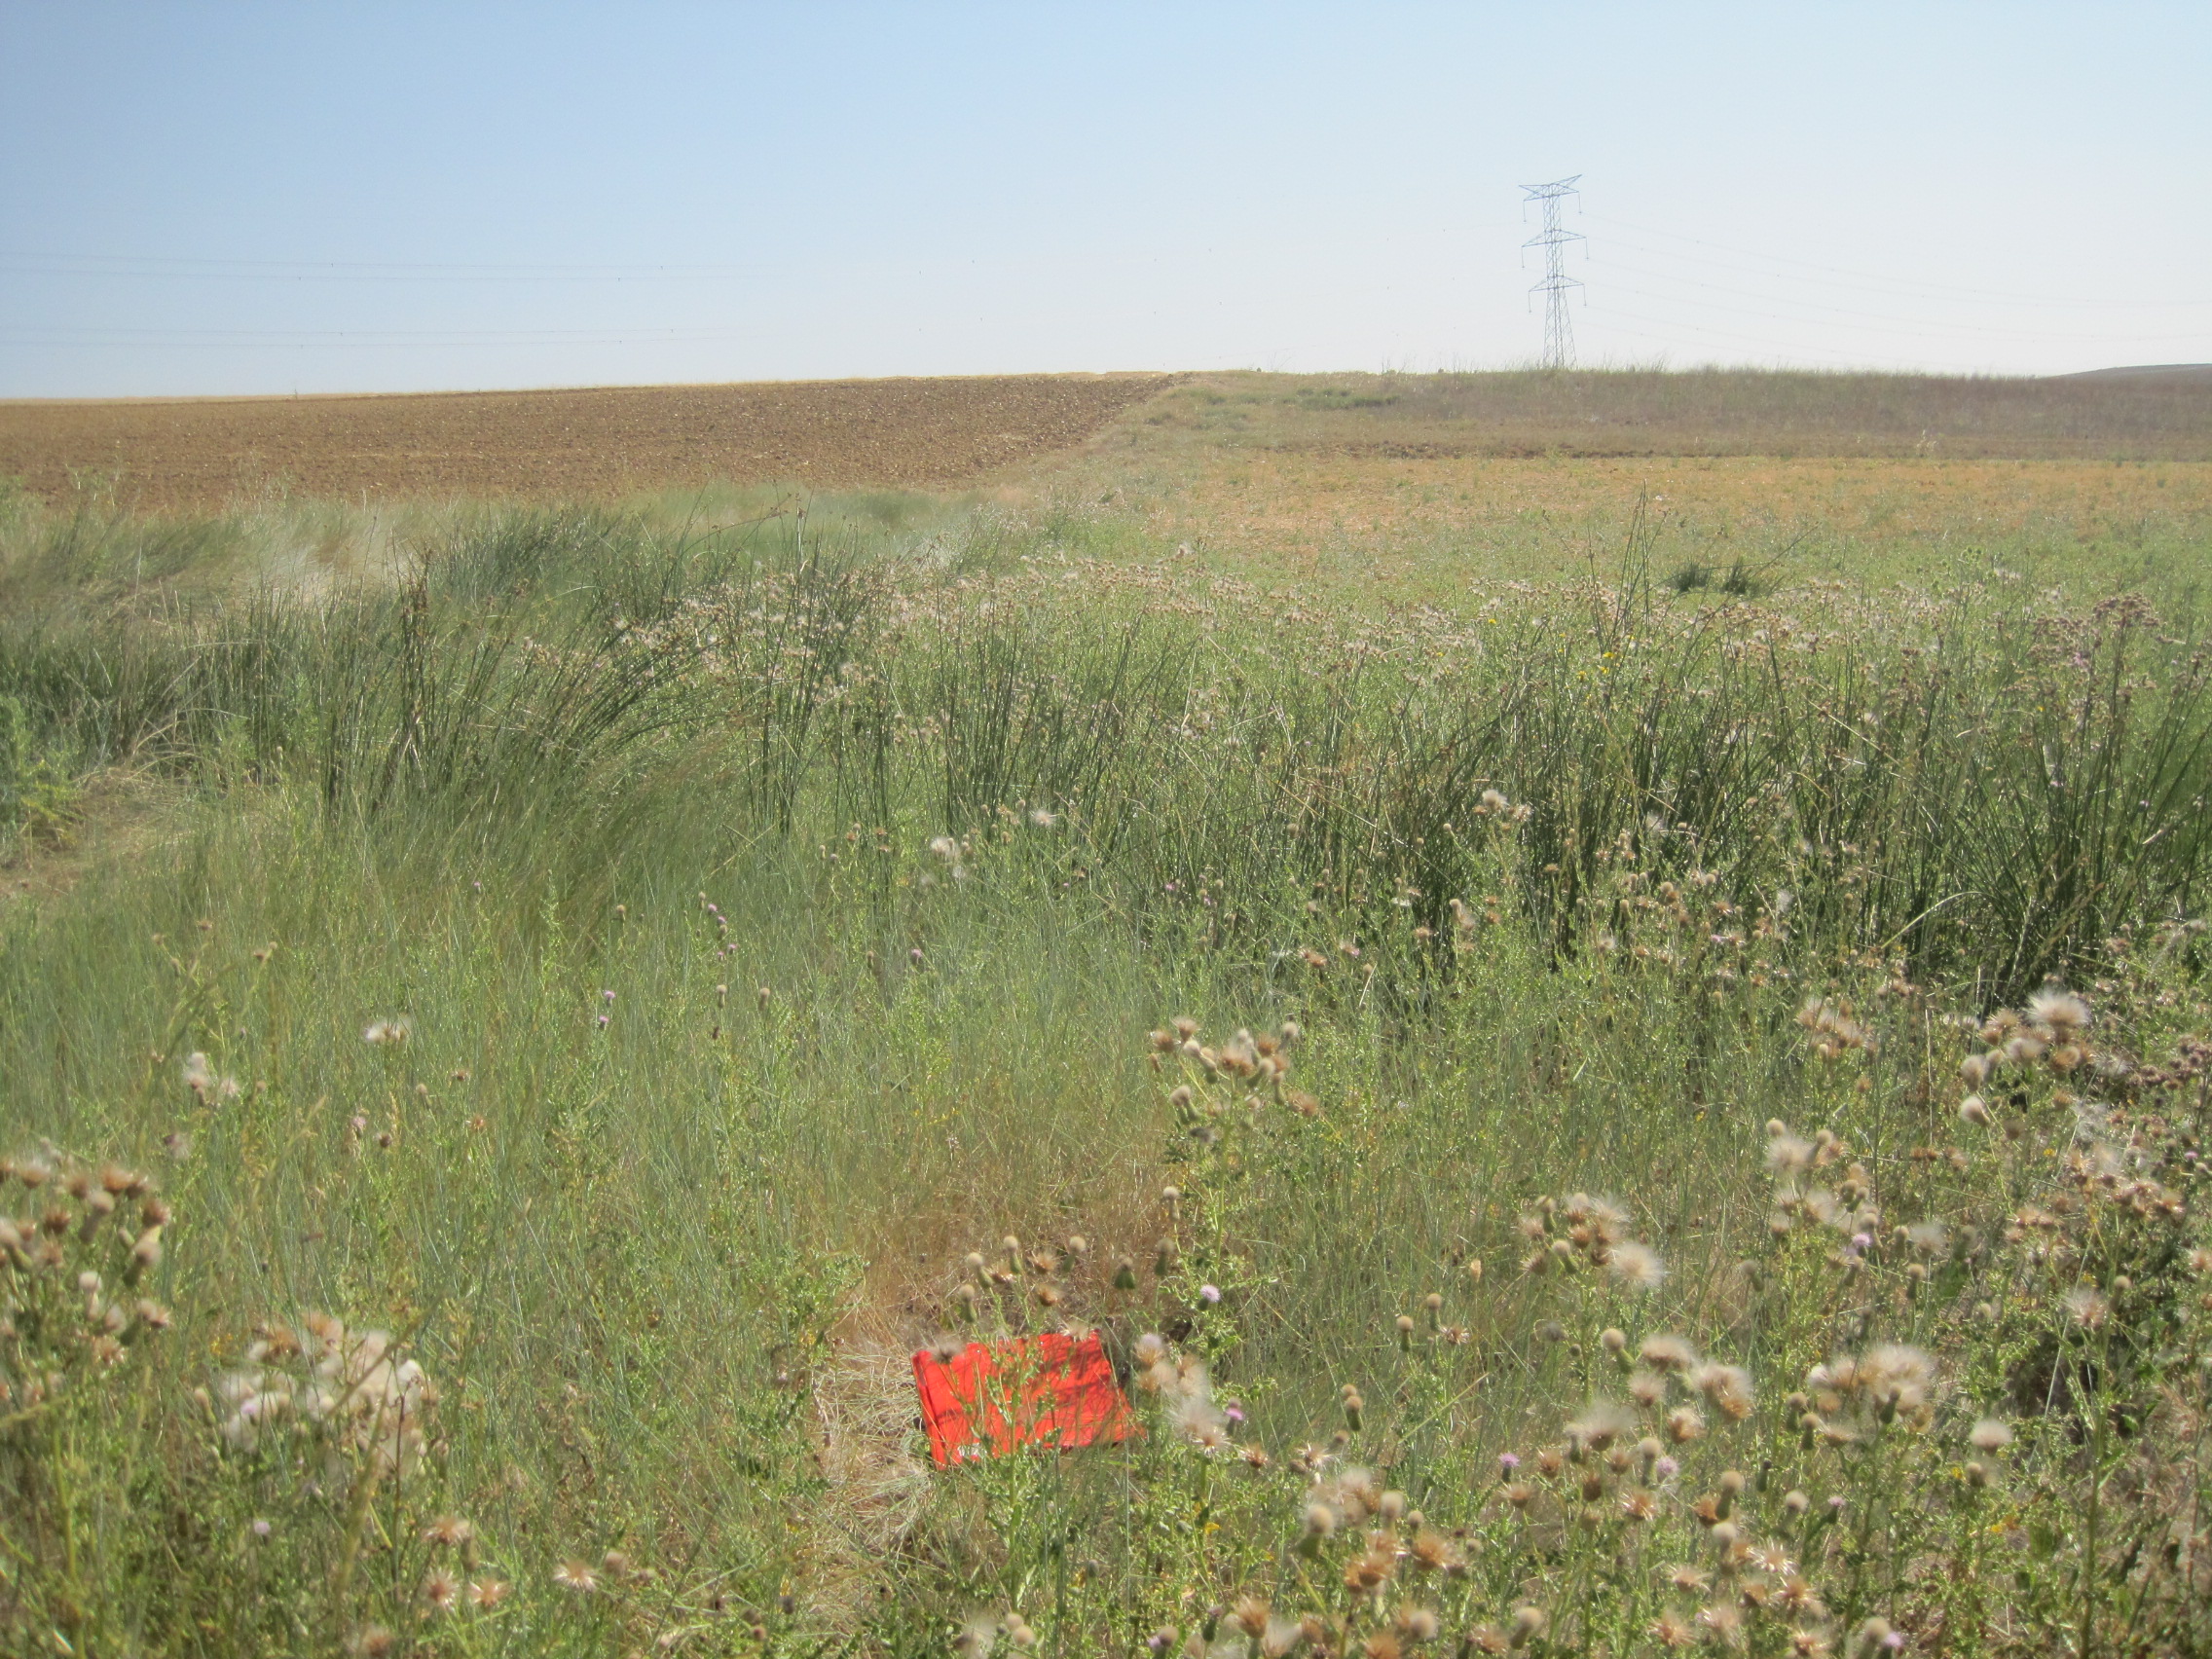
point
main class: Grassland
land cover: Grassland without tree/shrub cover
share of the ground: > 75 %
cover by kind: herbaceous plants 100 %
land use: Abandoned areas
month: July
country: ES
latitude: 41.6140
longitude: -5.4059
